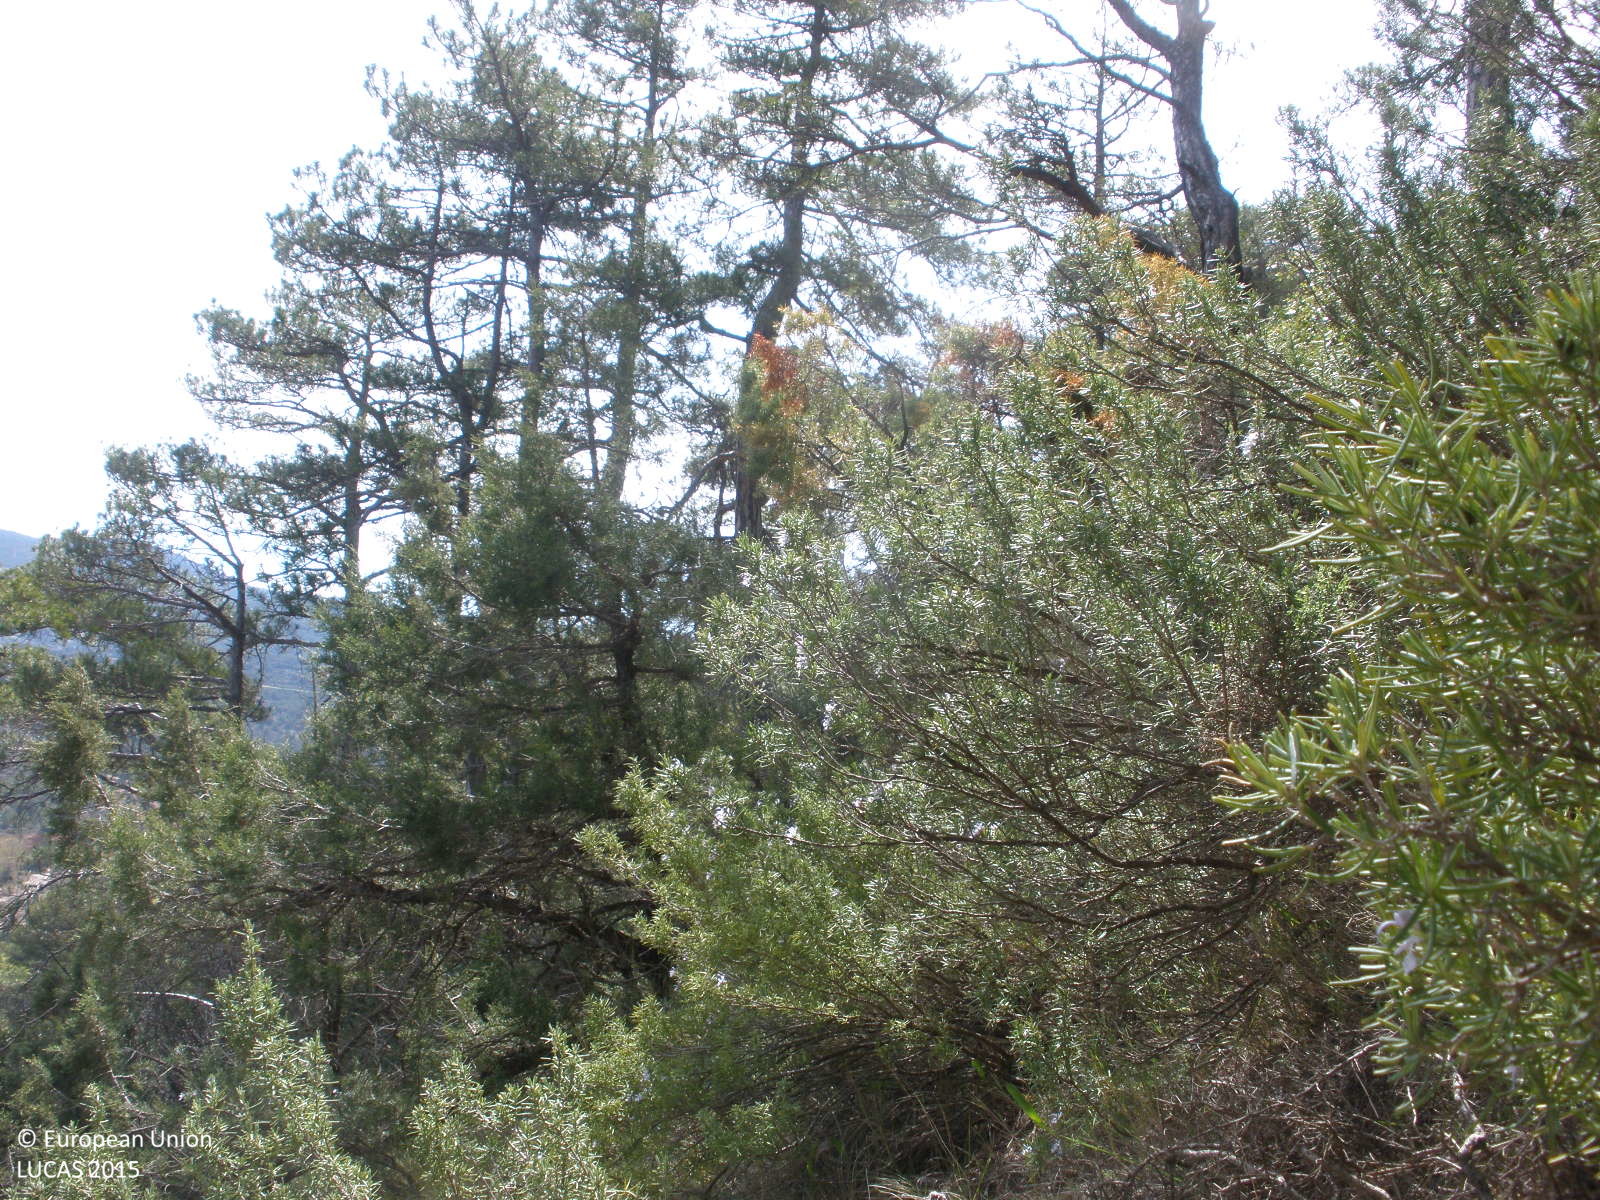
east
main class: Woodland
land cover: Pine dominated coniferous woodland
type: coniferous forest of the mediterranean region
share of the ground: > 75 %
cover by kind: coniferous forest trees 70 %, shrubs 30 %
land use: Semi-natural and natural areas not in use
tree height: > 5 m
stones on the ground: > 50 %
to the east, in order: Pine dominated coniferous woodland
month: April
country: ES
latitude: 40.0461
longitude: -1.1782
